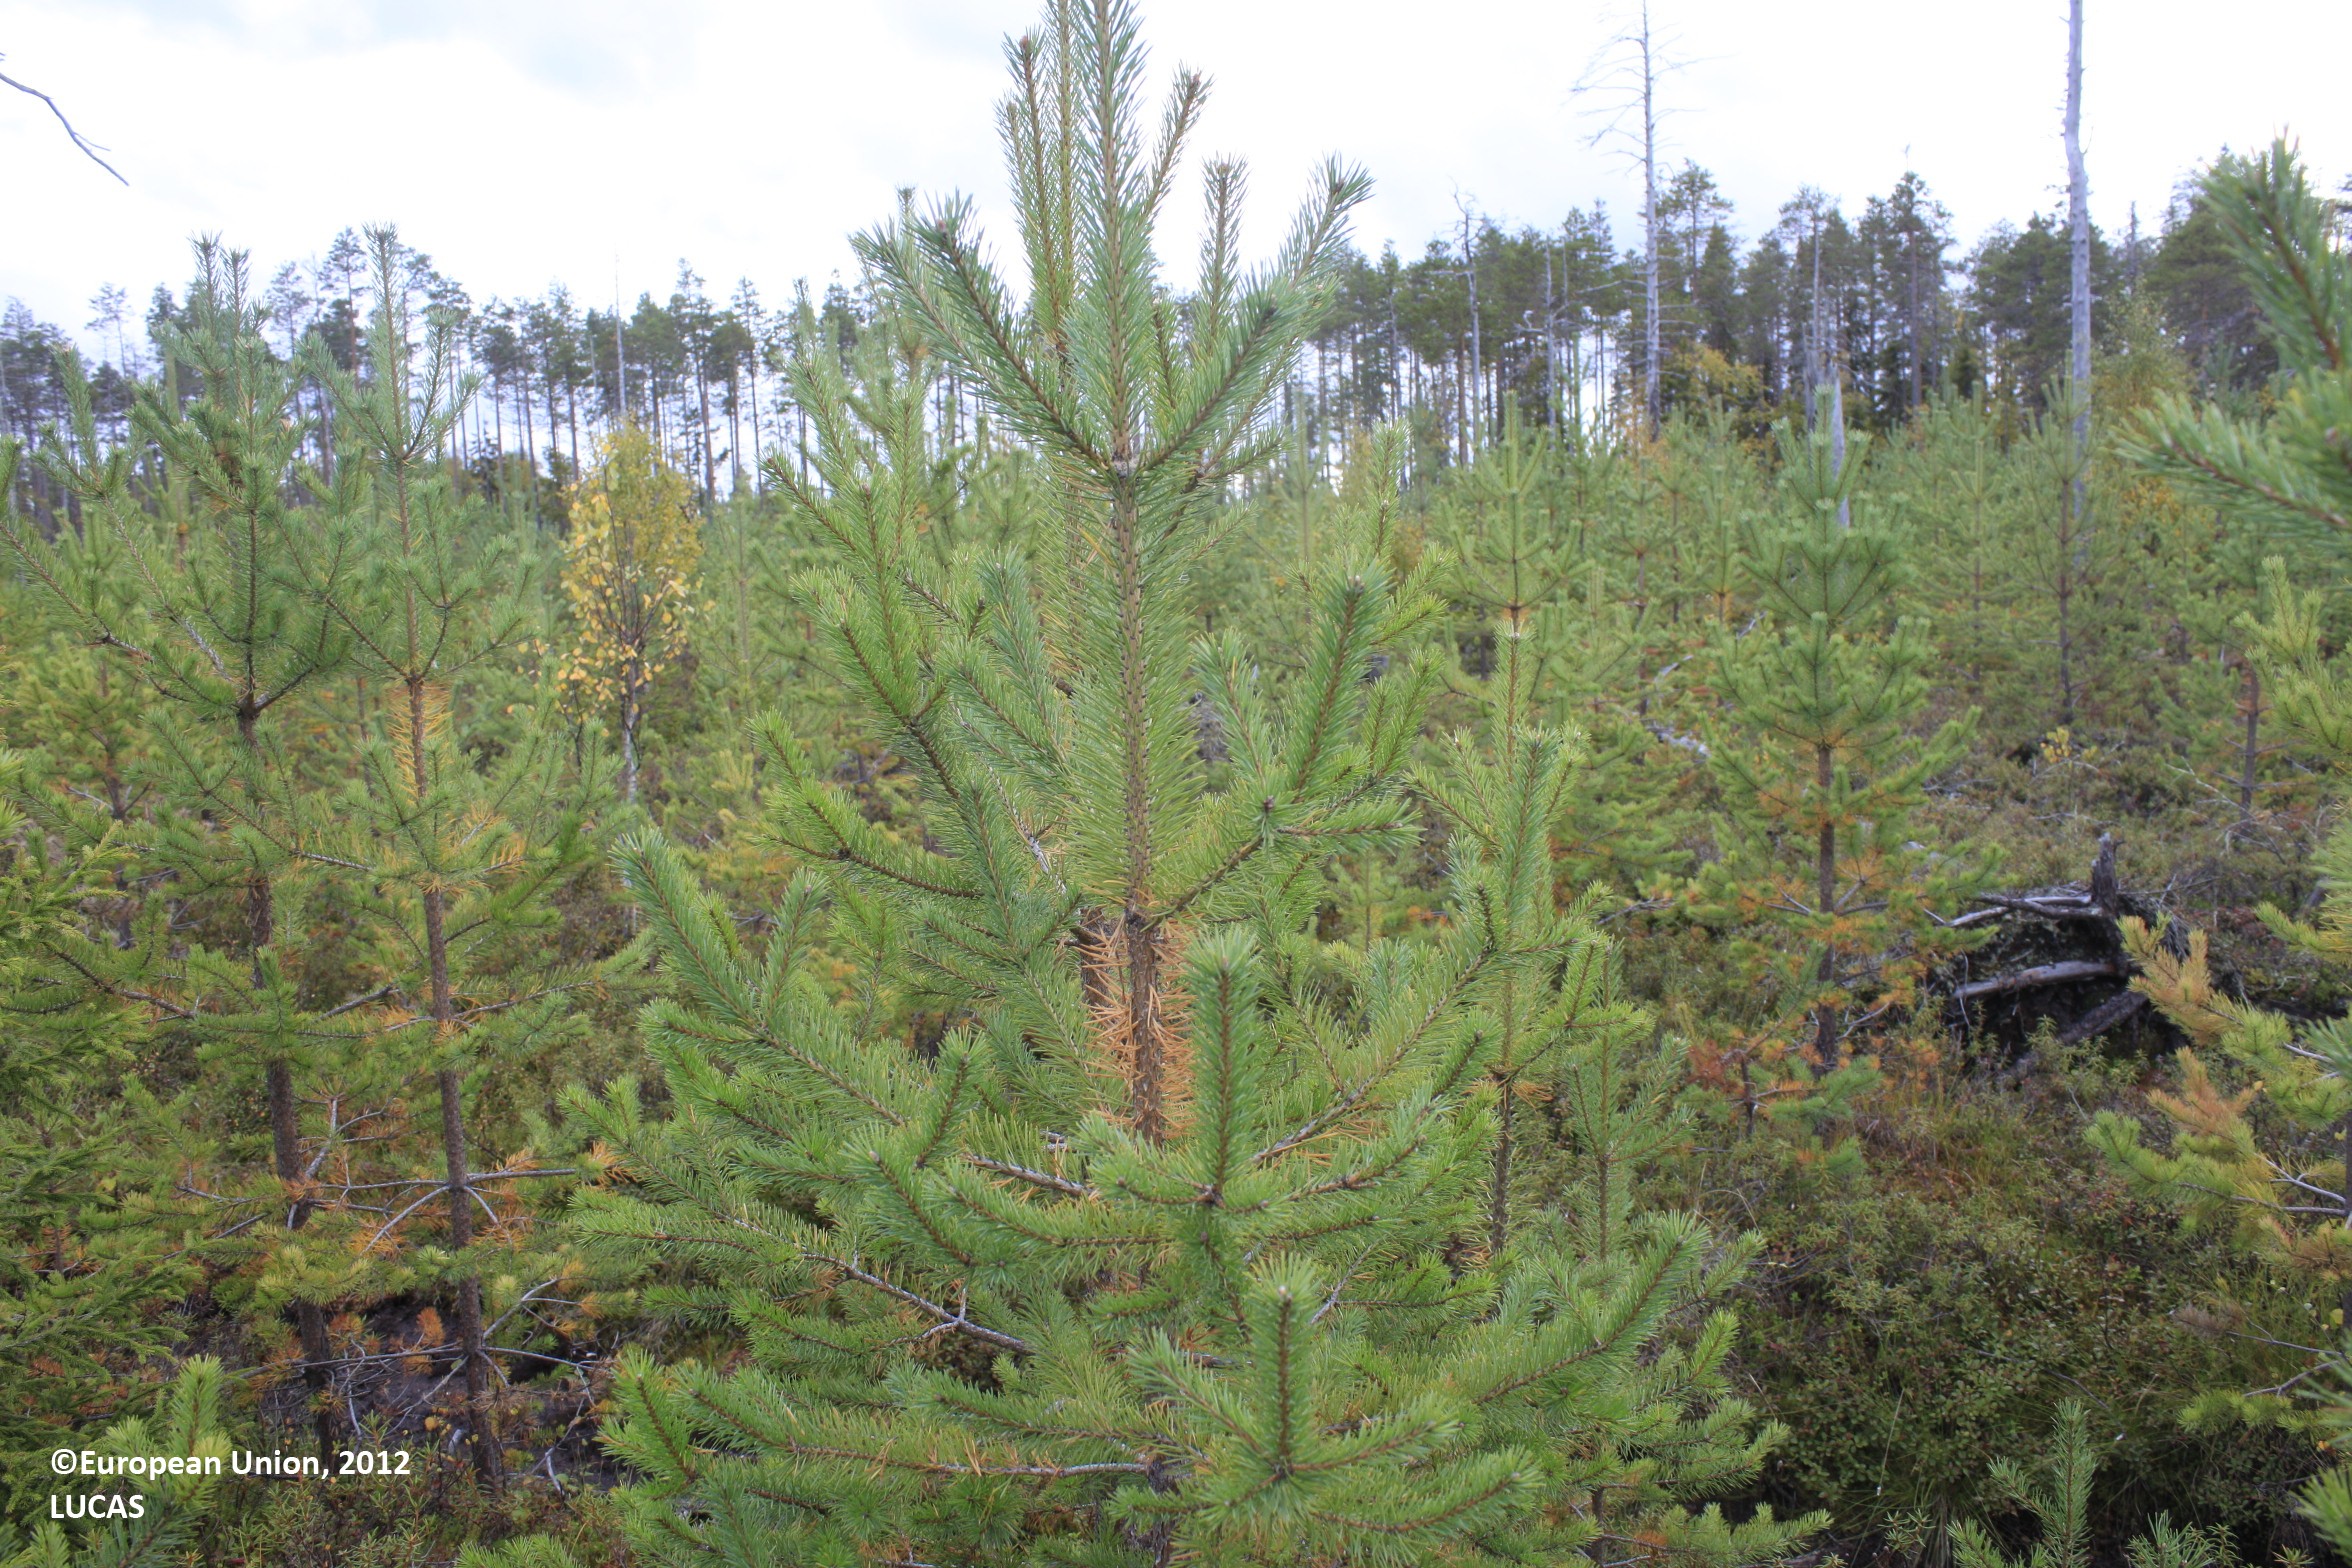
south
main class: Woodland
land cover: Pine dominated coniferous woodland
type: boreal forest
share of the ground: 50 - 75 %
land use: Forestry
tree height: < 5 m
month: September
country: FI
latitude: 65.4320
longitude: 27.0820
